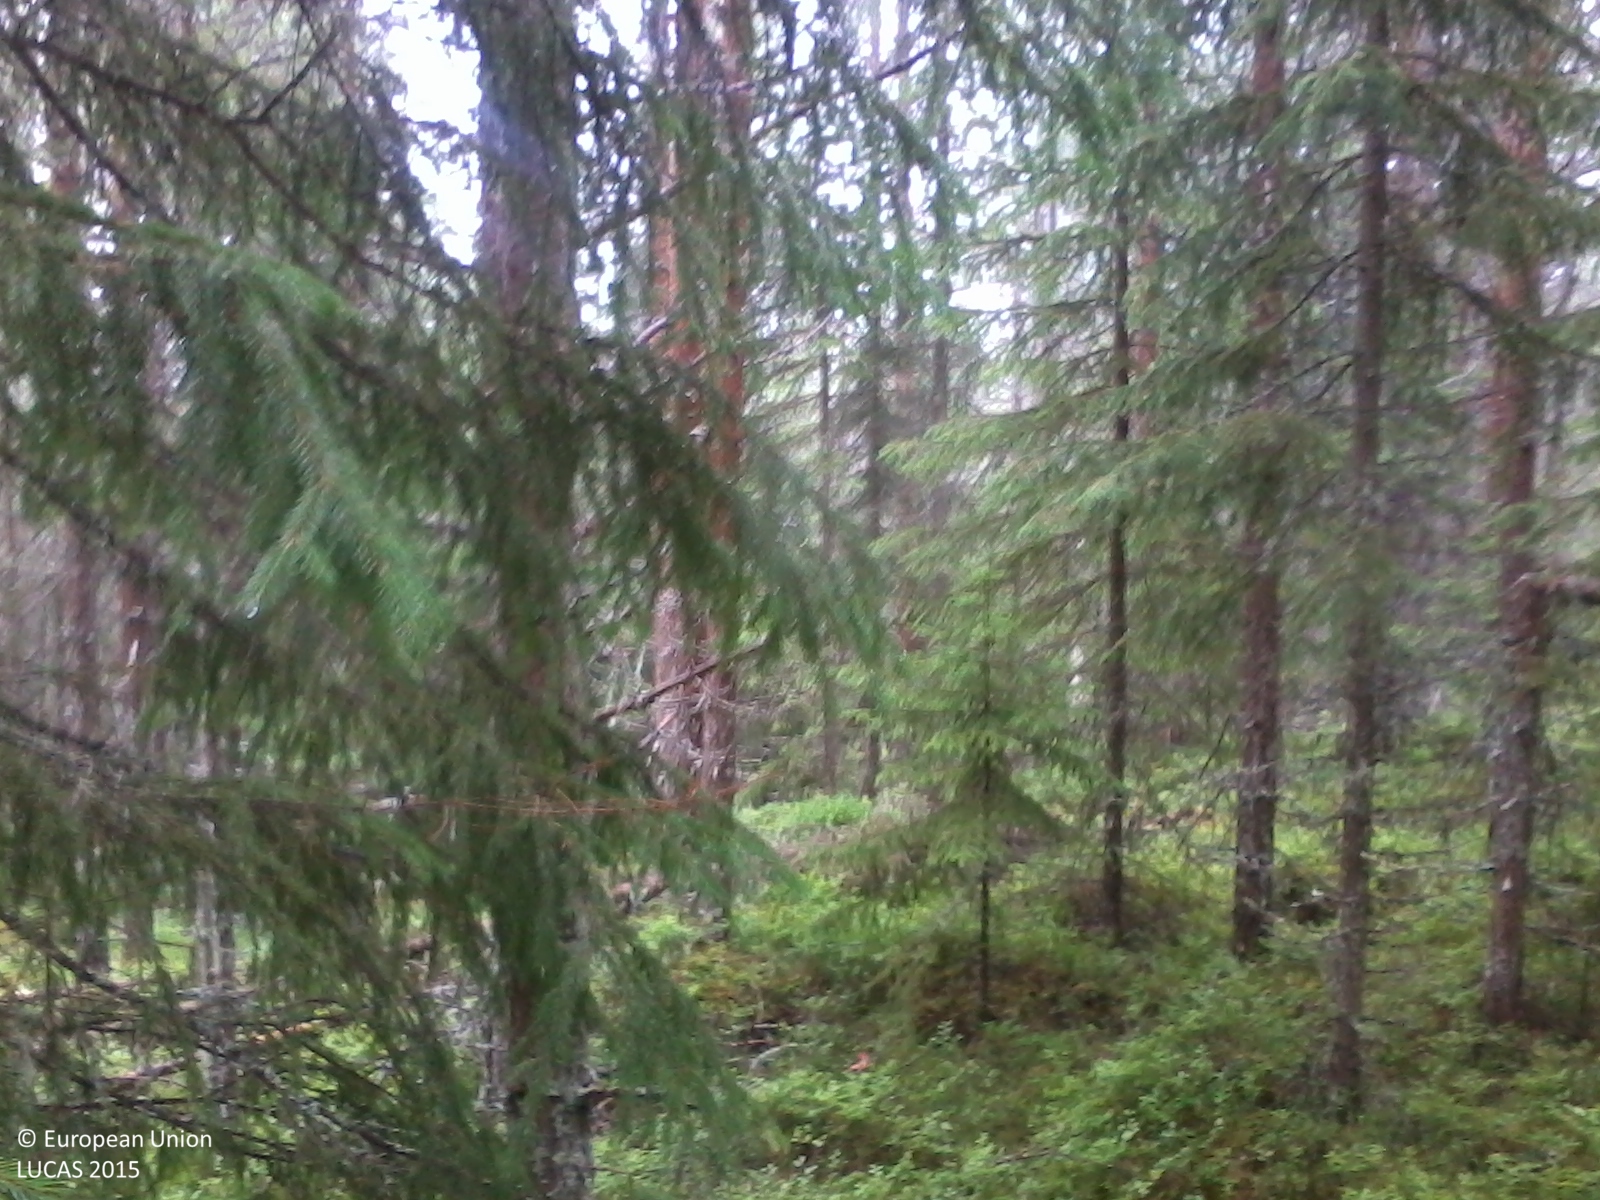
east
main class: Woodland
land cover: Pine dominated coniferous woodland
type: boreal forest
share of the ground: 50 - 75 %
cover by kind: coniferous forest trees 70 %, shrubs 30 %
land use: Forestry
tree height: > 5 m
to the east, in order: Pine dominated coniferous woodland; Pine dominated mixed woodland; Pine dominated coniferous woodland
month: August
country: SE
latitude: 62.8538
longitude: 16.8730
